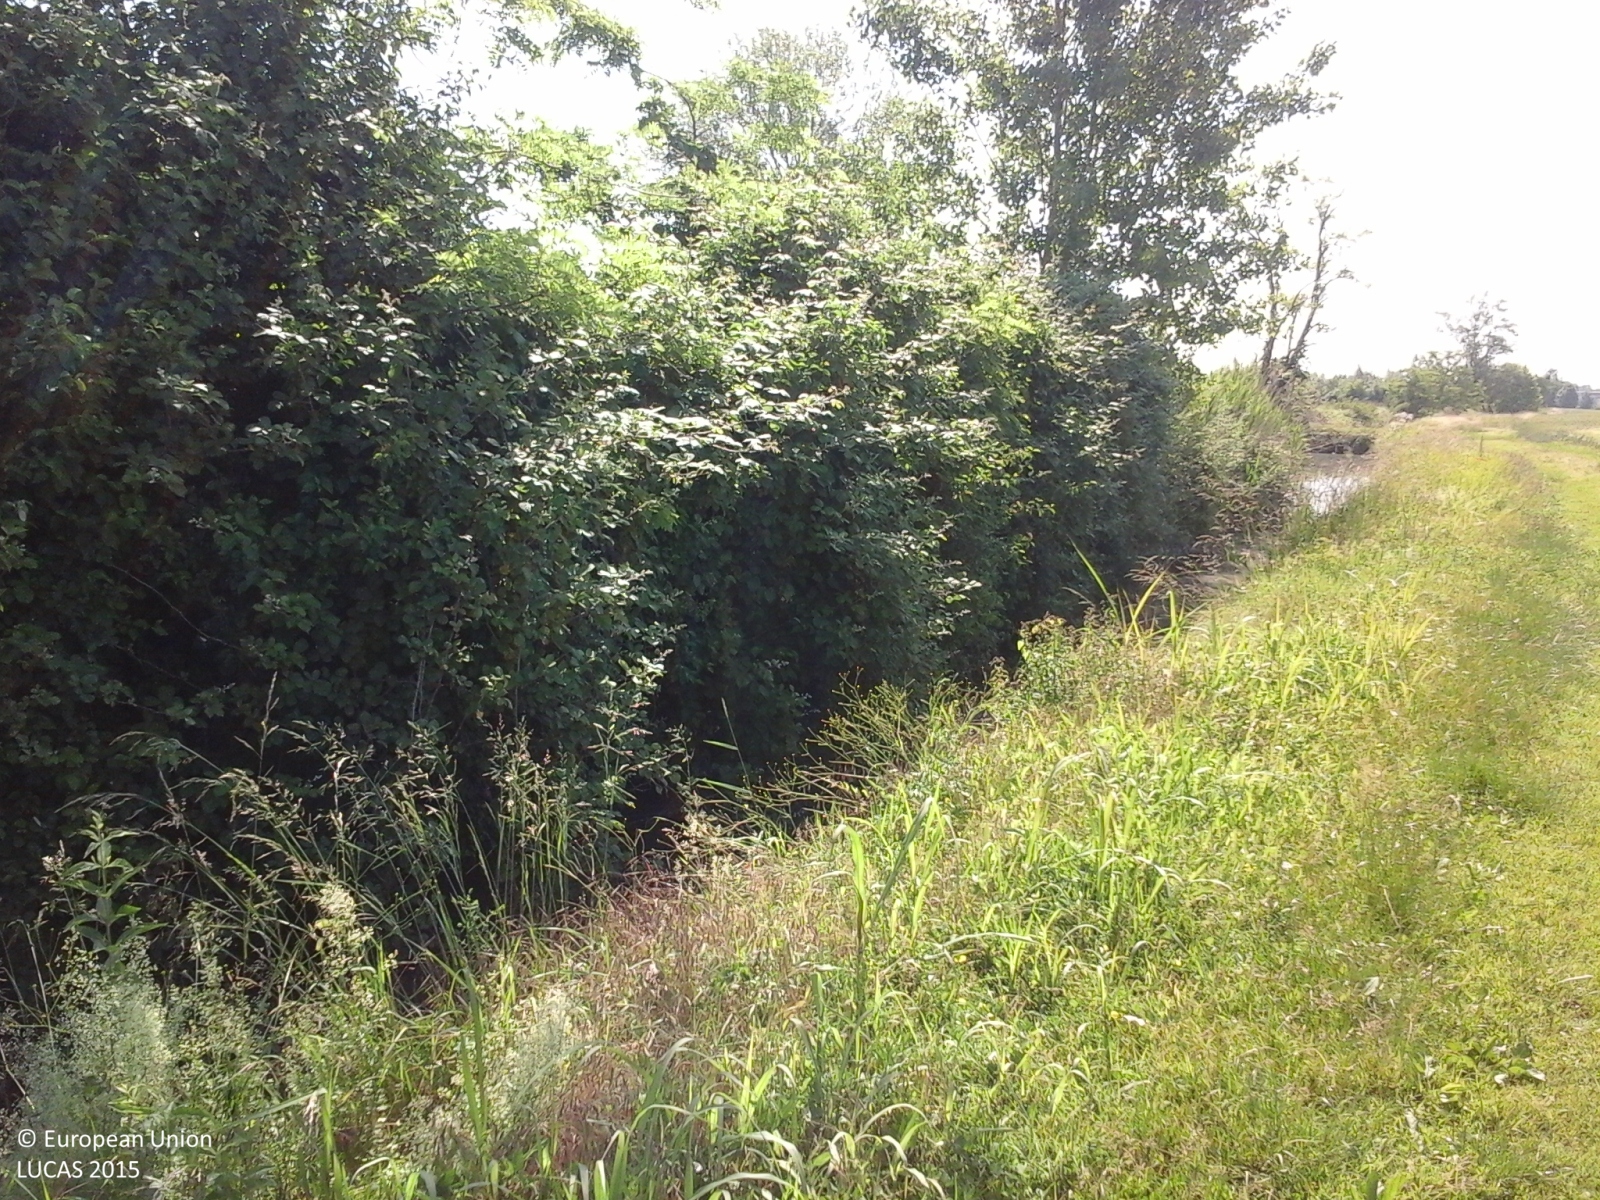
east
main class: Shrubland
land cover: Shrubland with sparse tree cover
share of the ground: > 75 %
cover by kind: shrubs 65 %, herbaceous plants 30 %, broadleaved forest trees 5 %
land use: Semi-natural and natural areas not in use
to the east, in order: Shrubland with sparse tree cover; Inland fresh running water; Shrubland without tree cover; Inland fresh running water; Spontaneously vegetated surfaces; Grass margins; Barley; Tracks; Single bushes/trees; Soya; Ditches and canals; Soya
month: May
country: IT
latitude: 45.1398
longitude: 10.9266
